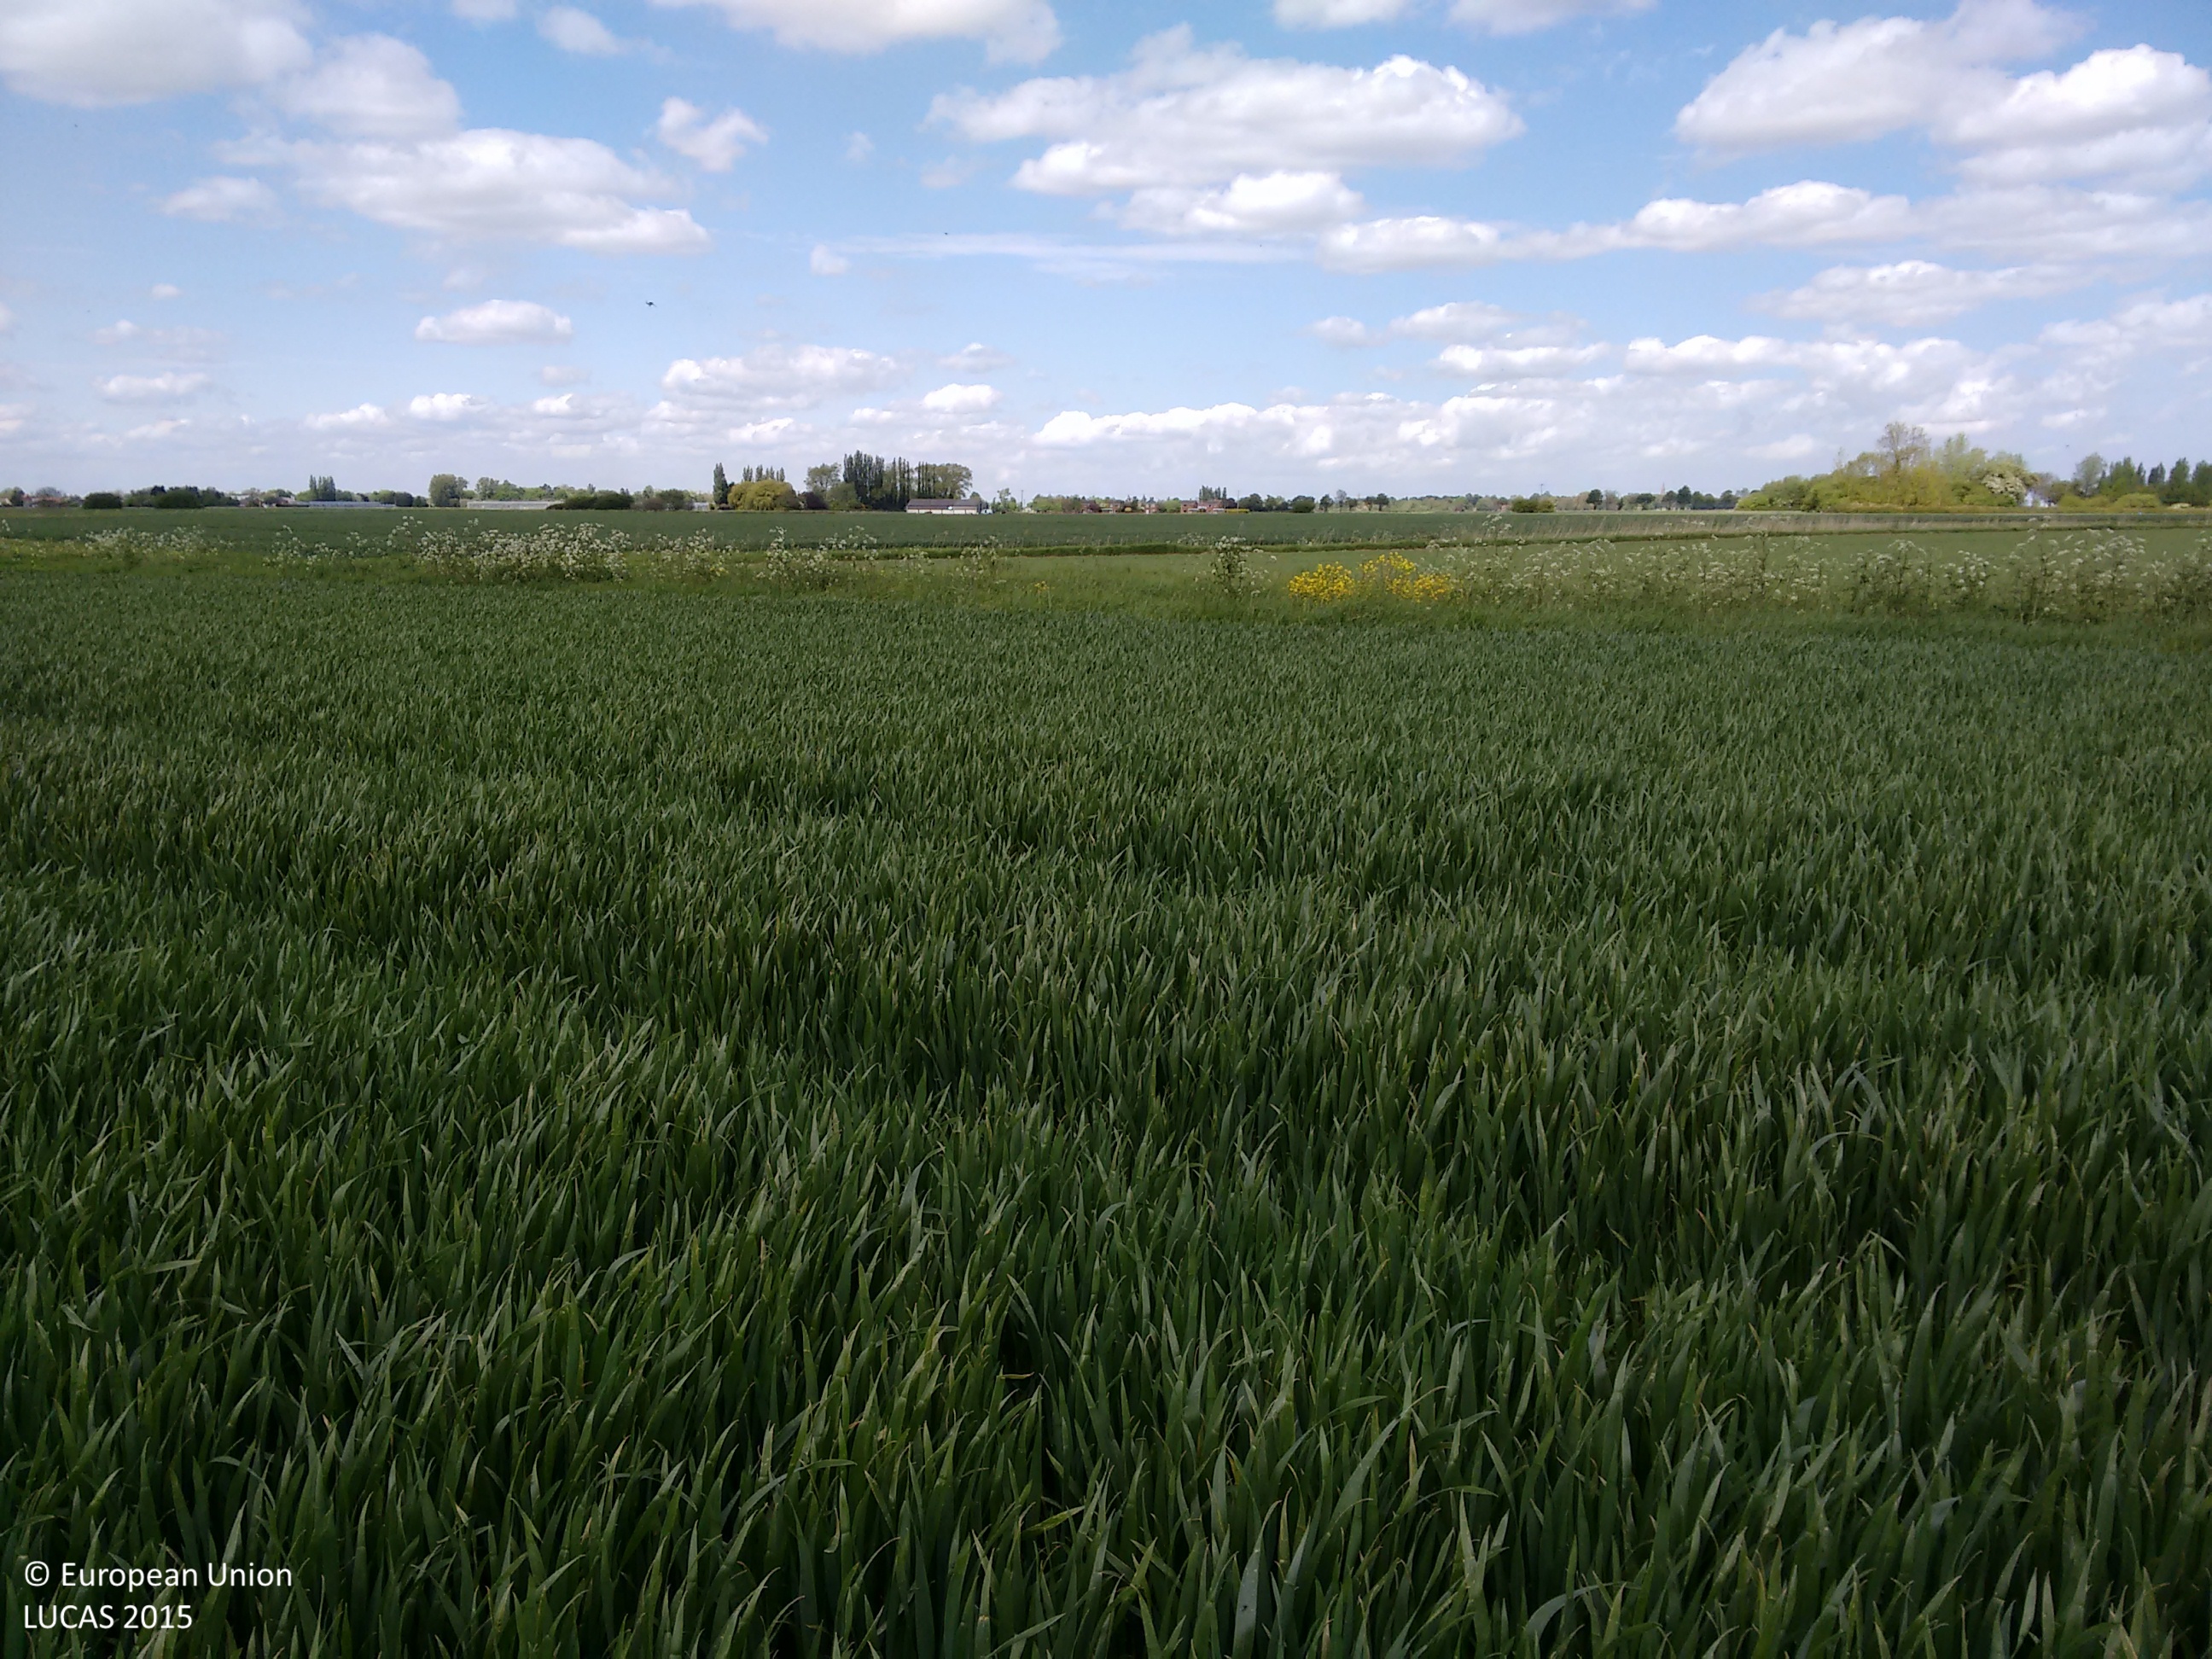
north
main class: Cropland
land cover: Common wheat
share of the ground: > 75 %
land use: Agriculture (excluding fallow land and kitchen gardens)
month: May
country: GB
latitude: 52.9112
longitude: -0.0402
